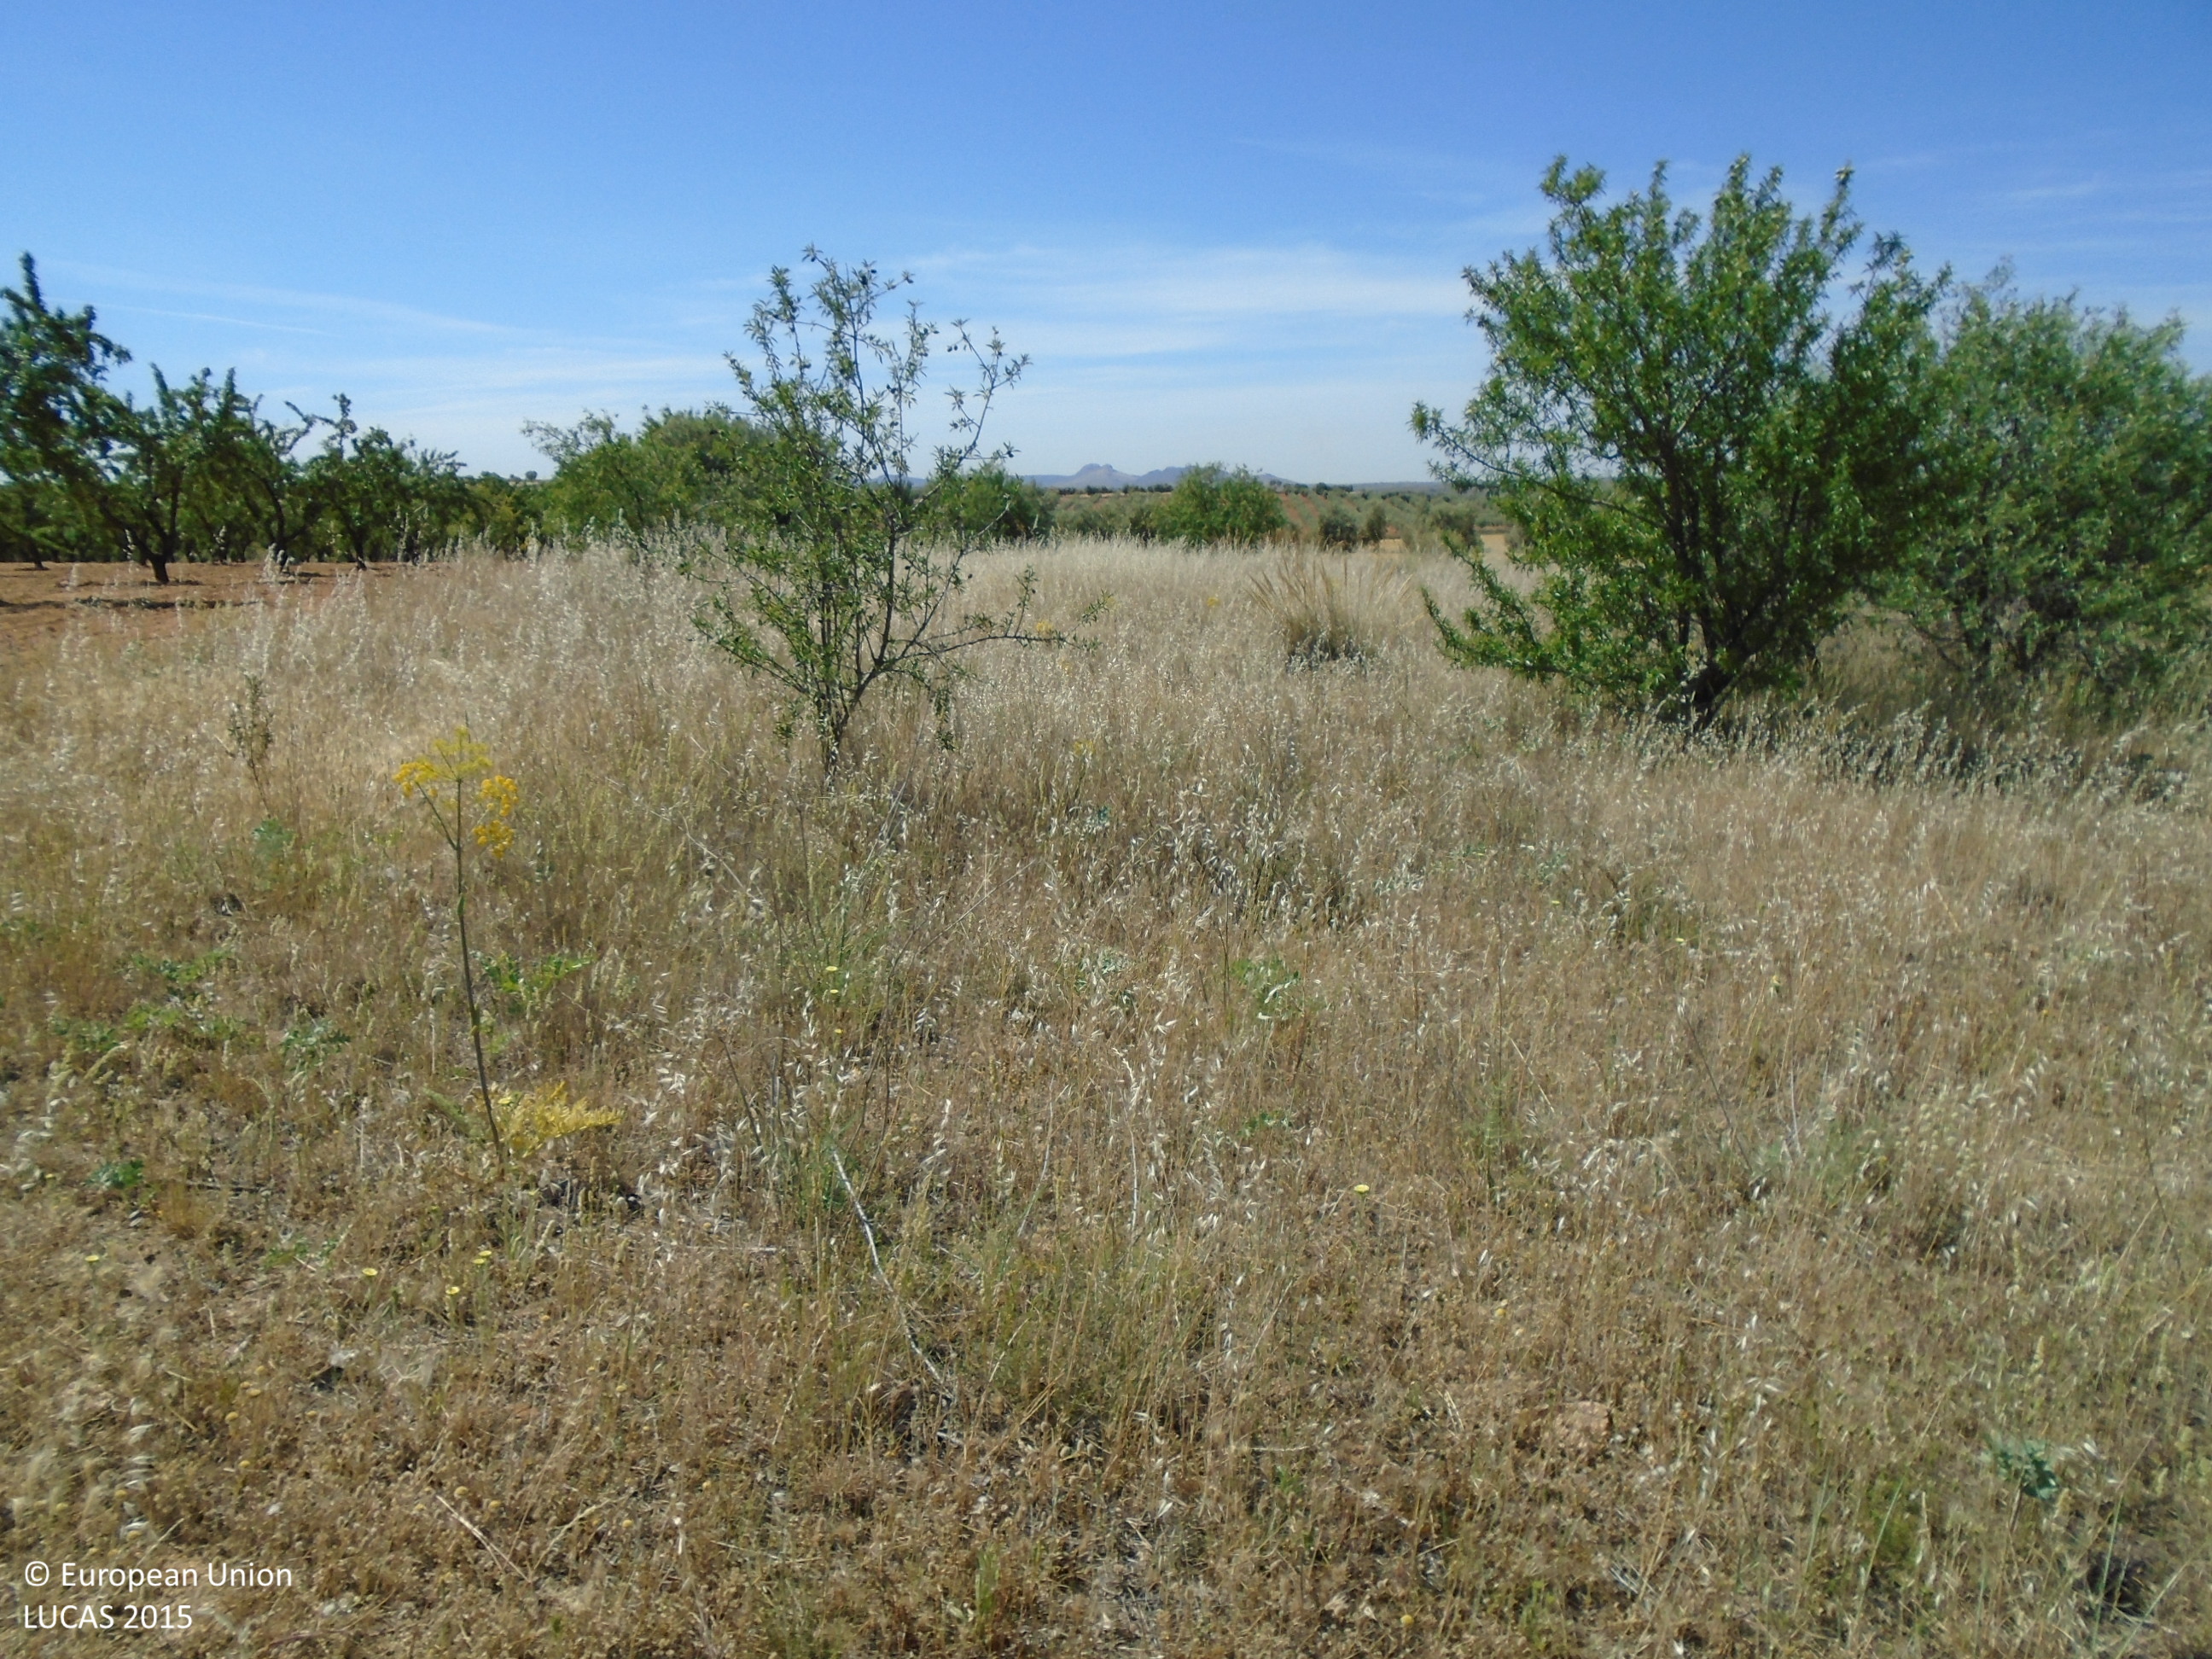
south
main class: Grassland
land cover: Grassland without tree/shrub cover
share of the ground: > 75 %
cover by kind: herbaceous plants 95 %, shrubs 5 %
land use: Abandoned areas
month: May
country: ES
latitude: 39.8098
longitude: -3.7315
